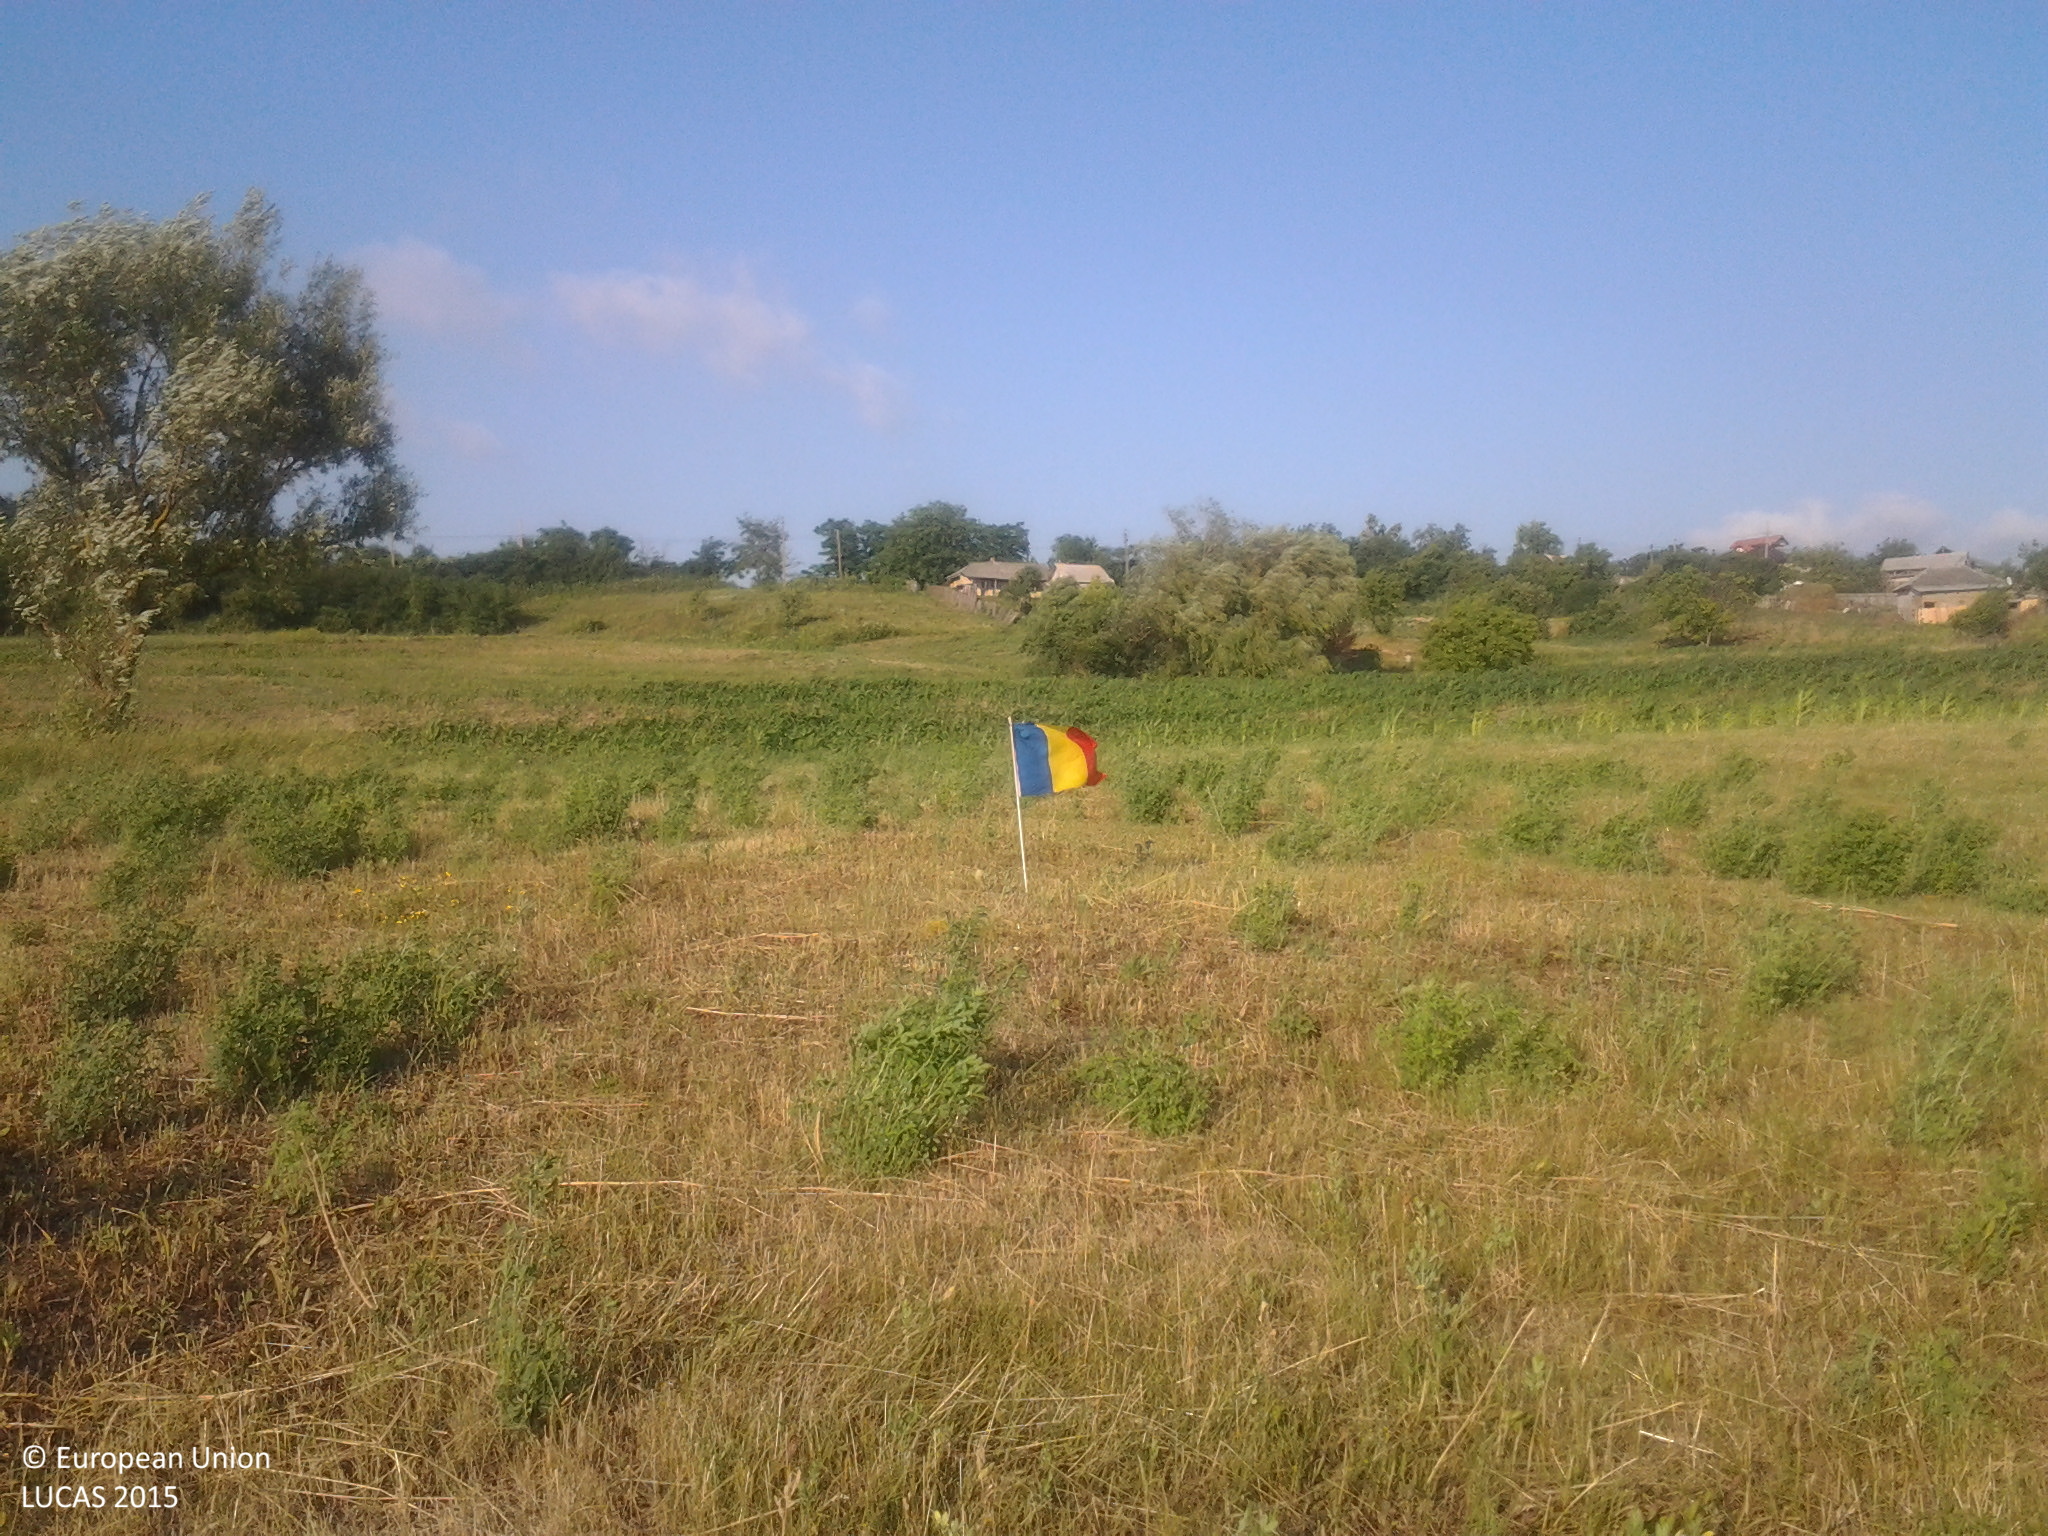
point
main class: Cropland
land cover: Other leguminous and mixtures for fodder
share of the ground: > 75 %
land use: Agriculture (excluding fallow land and kitchen gardens)
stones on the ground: < 10 %
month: June
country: RO
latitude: 46.6317
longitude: 27.1199
